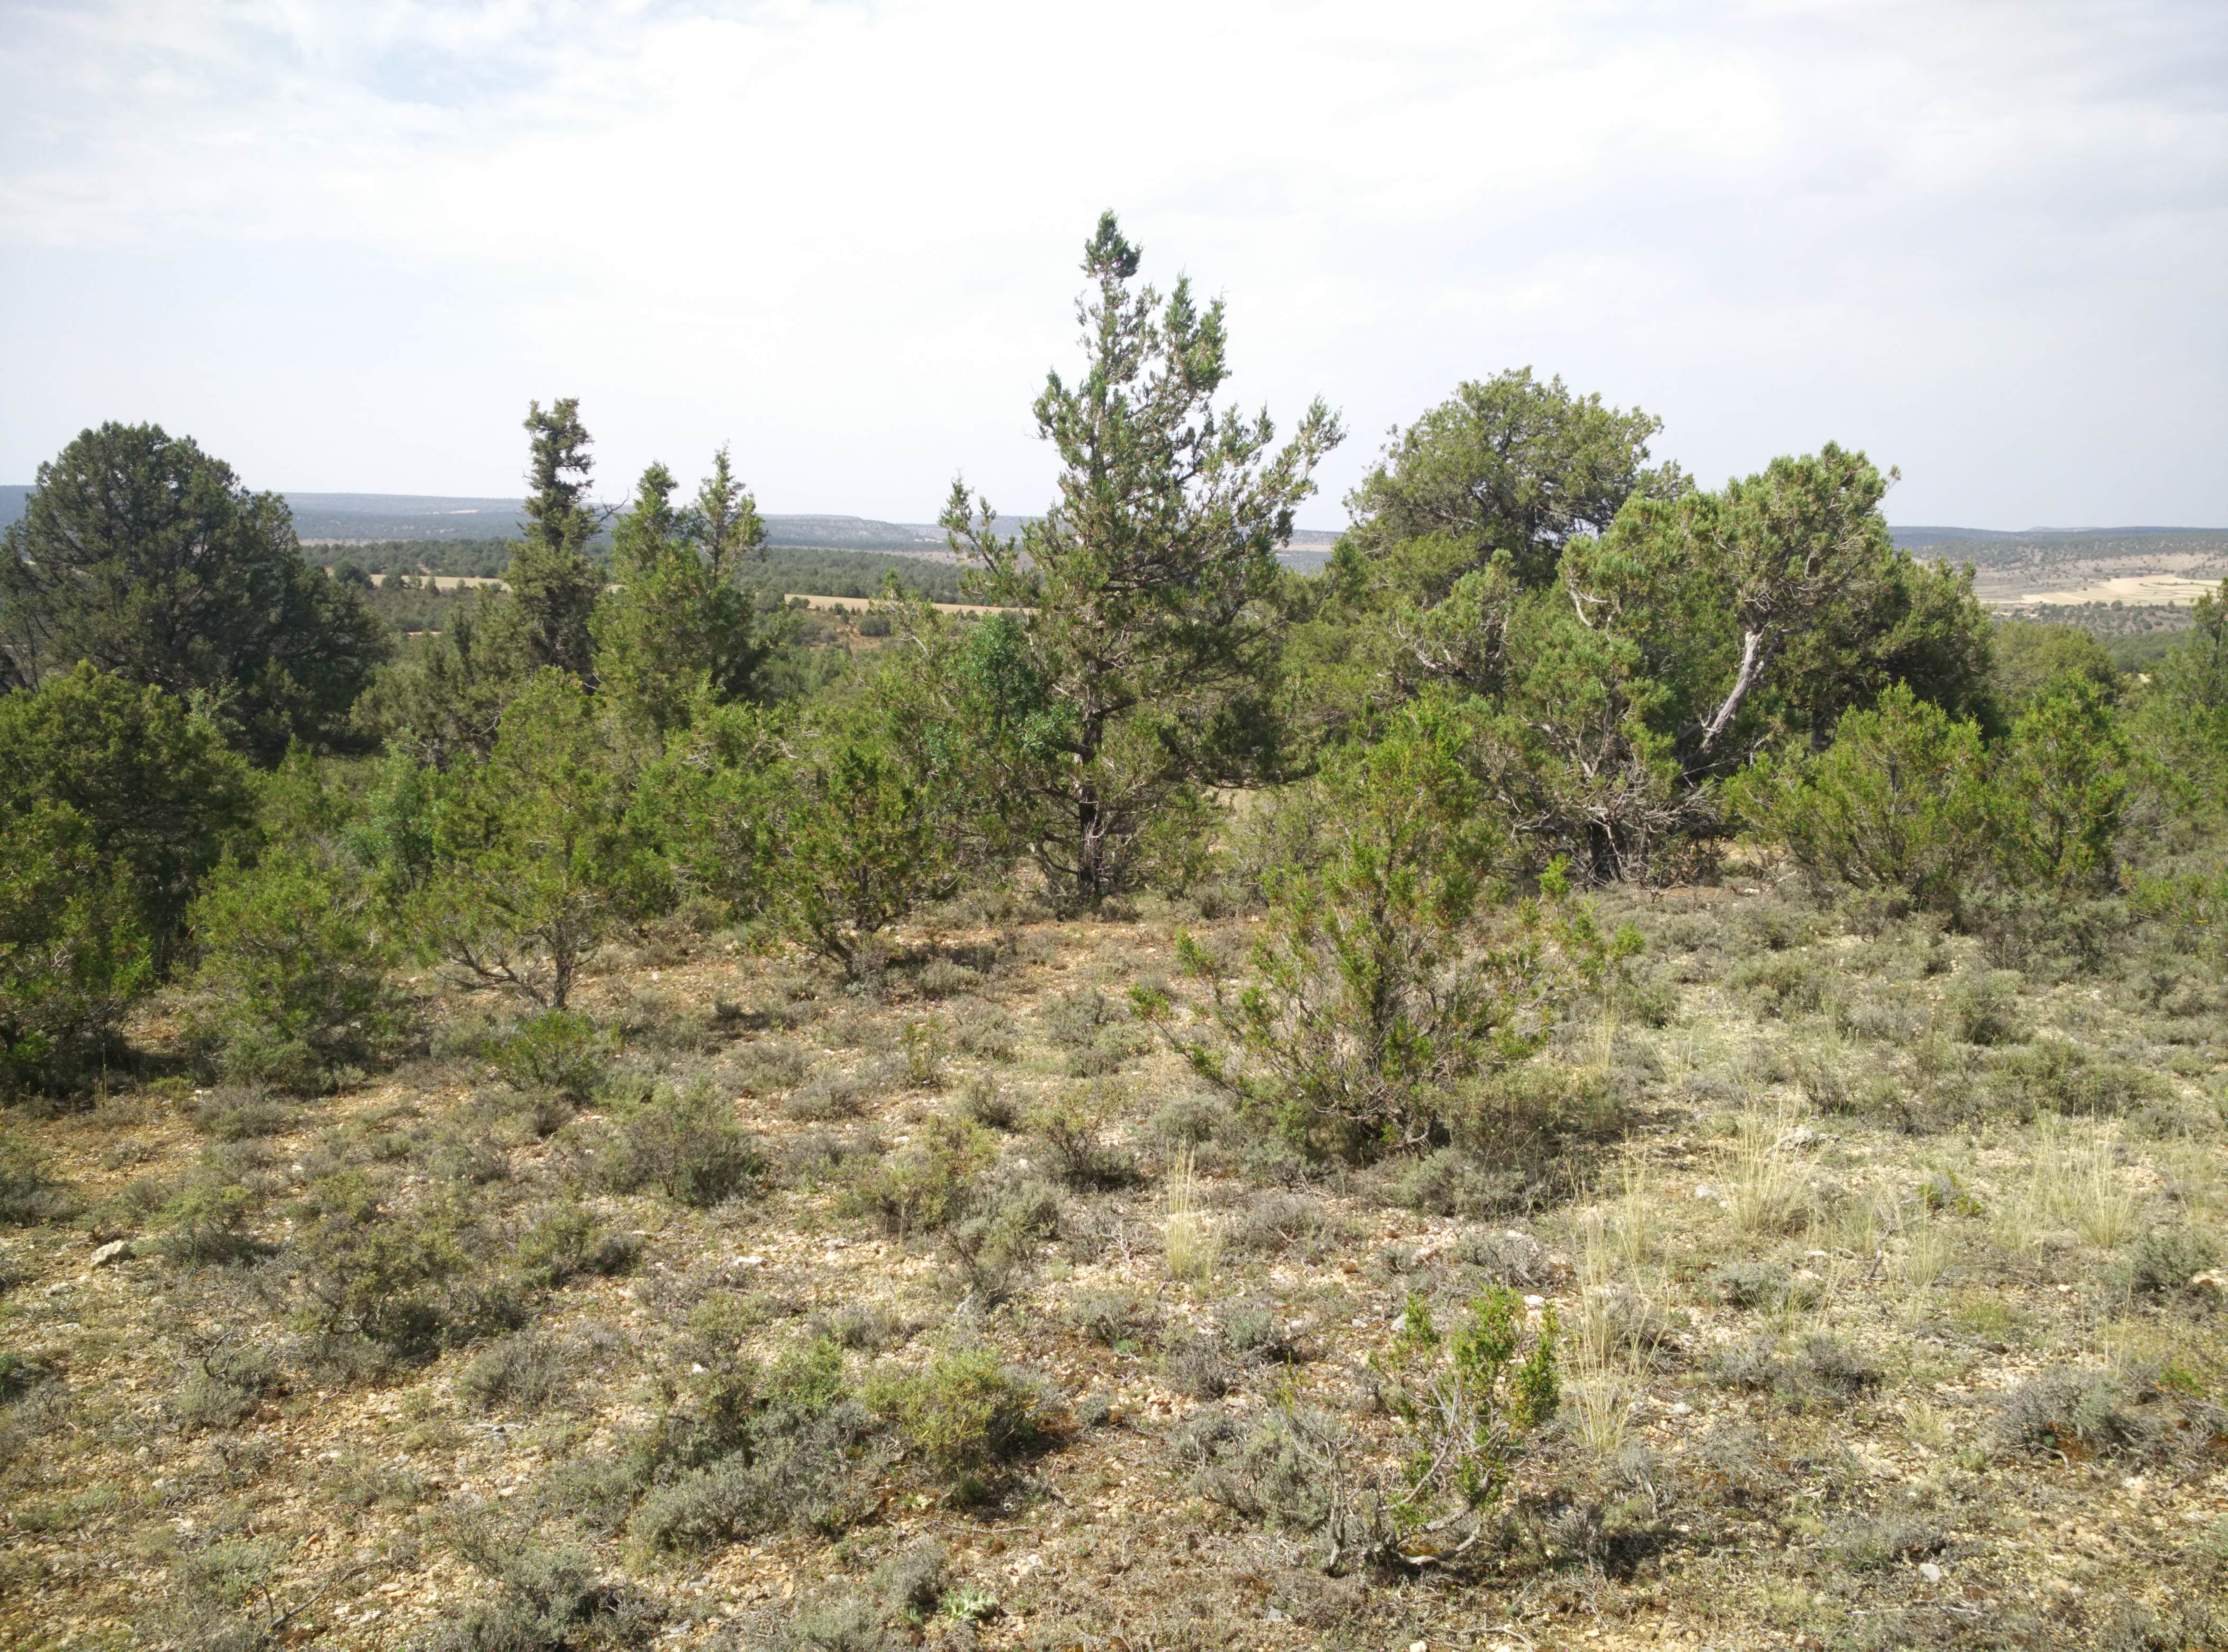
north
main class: Woodland
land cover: Other coniferous woodland
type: coniferous forest of the mediterranean region
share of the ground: 25 - 50 %
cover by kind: unconsolidated bare surface 40 %, coniferous forest trees 30 %, shrubs 20 %, herbaceous plants 5 %, lichens and mosses 5 %
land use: Semi-natural and natural areas not in use
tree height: > 5 m
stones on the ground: < 10 %
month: July
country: ES
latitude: 40.9840
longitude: -2.0415
